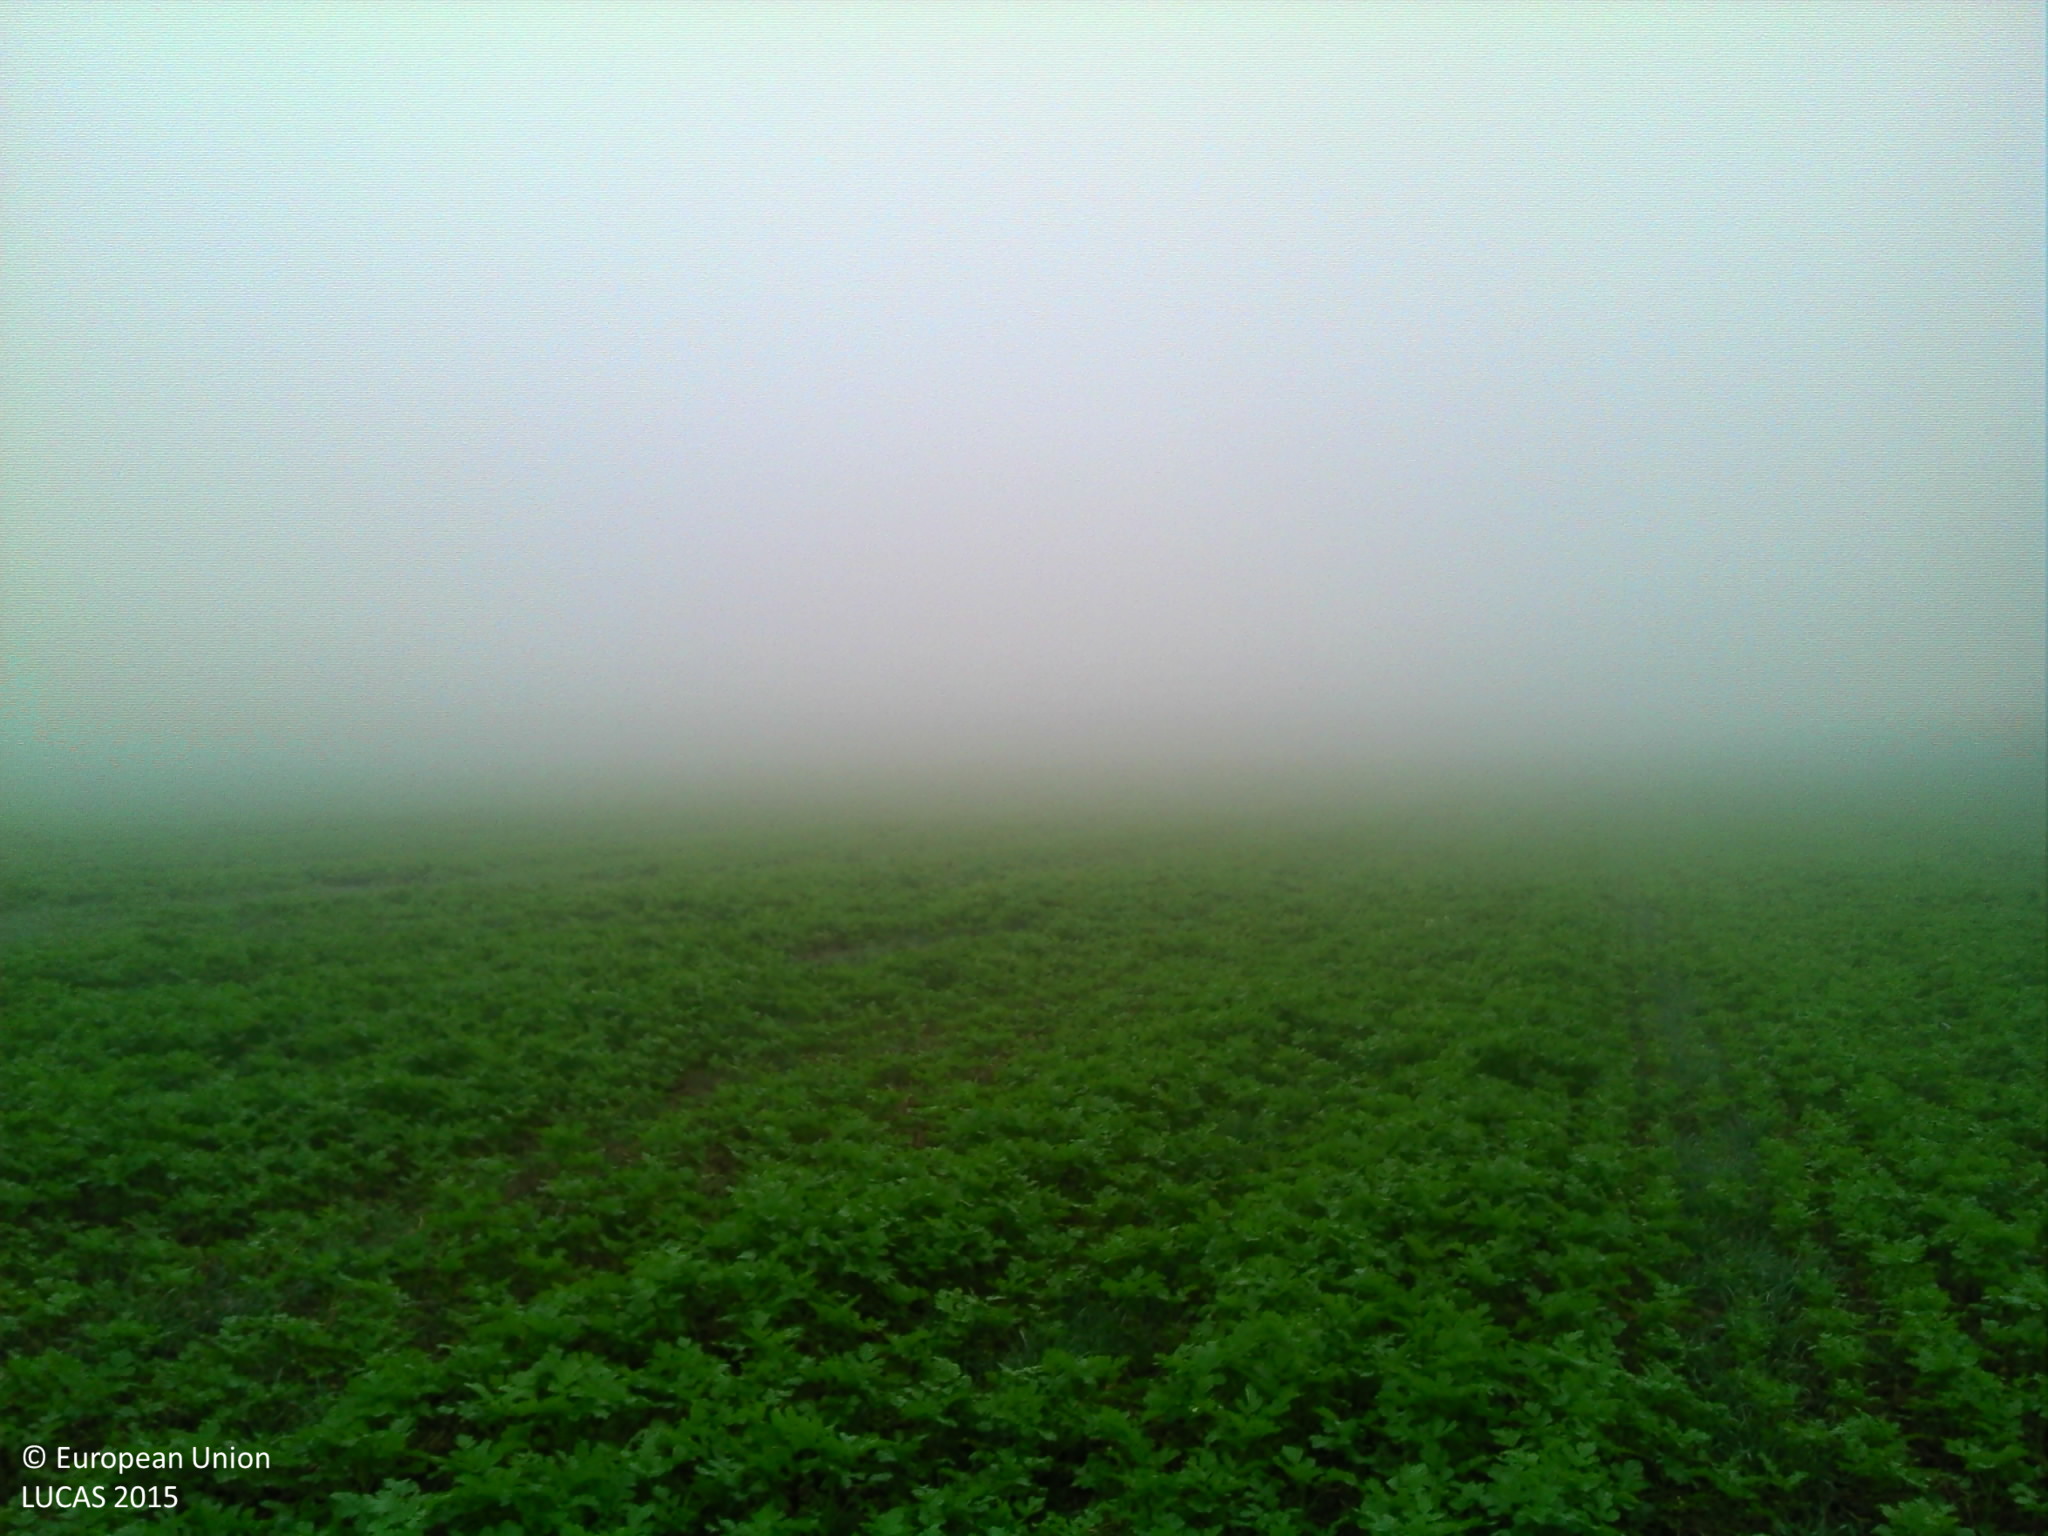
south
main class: Cropland
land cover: Other fibre and oleaginous crops
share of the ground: > 75 %
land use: Agriculture (excluding fallow land and kitchen gardens)
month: October
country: FR
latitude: 49.7951
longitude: 4.0629
